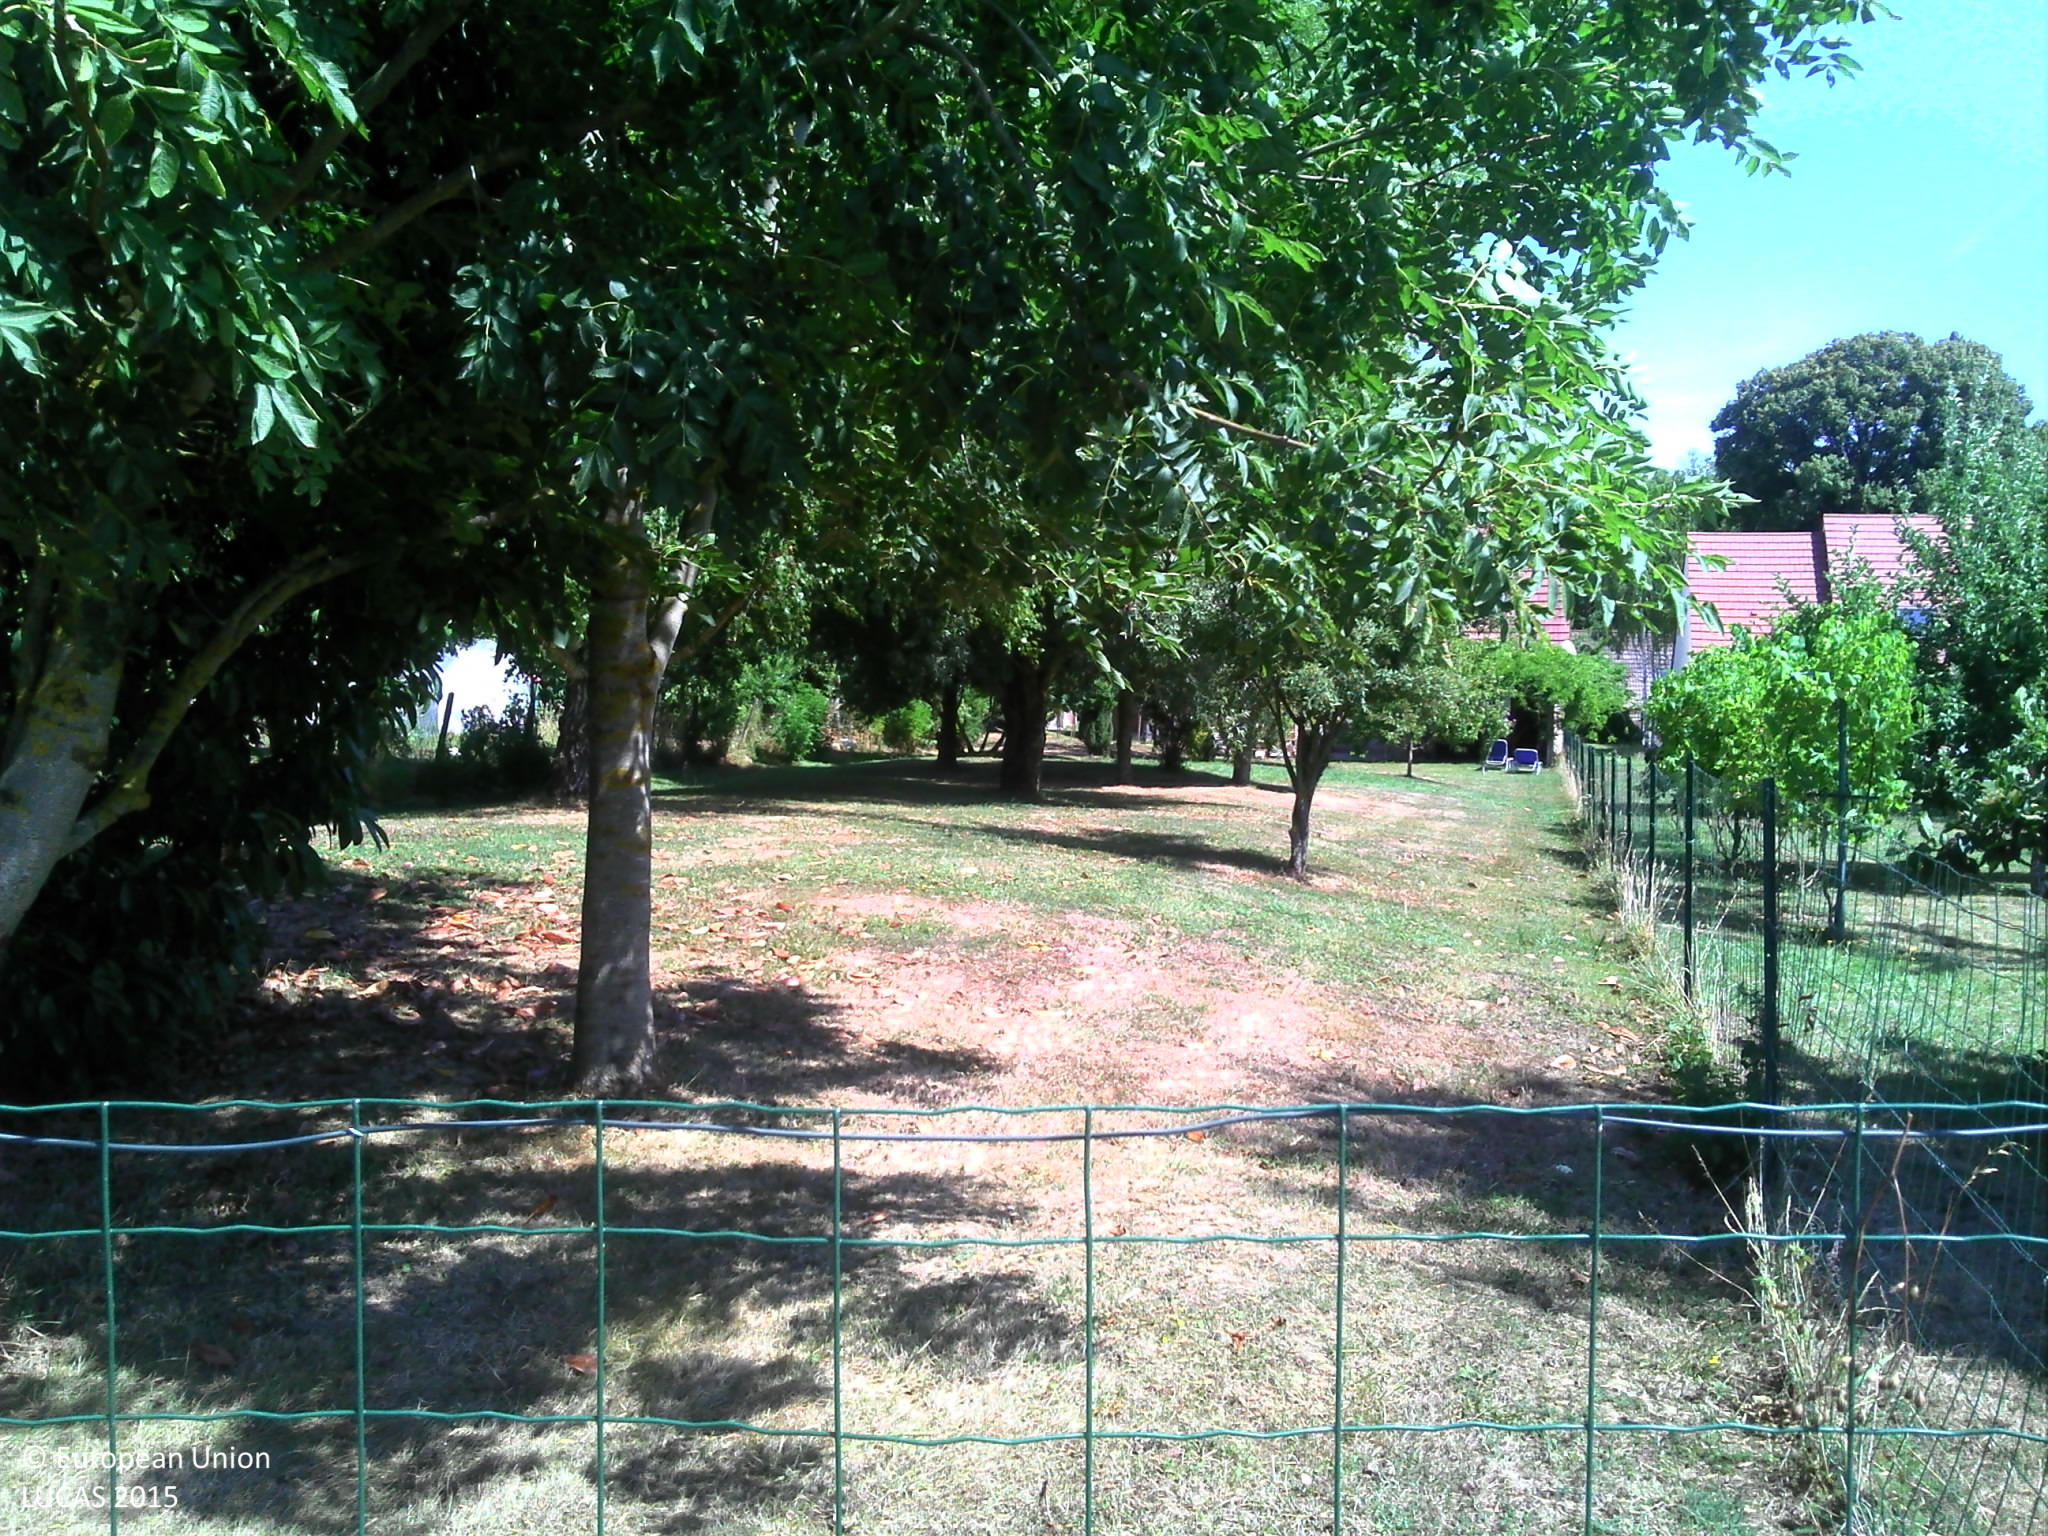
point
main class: Grassland
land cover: Grassland with sparse tree/shrub cover
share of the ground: > 75 %
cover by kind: herbaceous plants 85 %, broadleaved forest trees 5 %, consolidated bare surface 5 %
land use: Residential
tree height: < 5 m
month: August
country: FR
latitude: 48.8502
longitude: 3.3013
